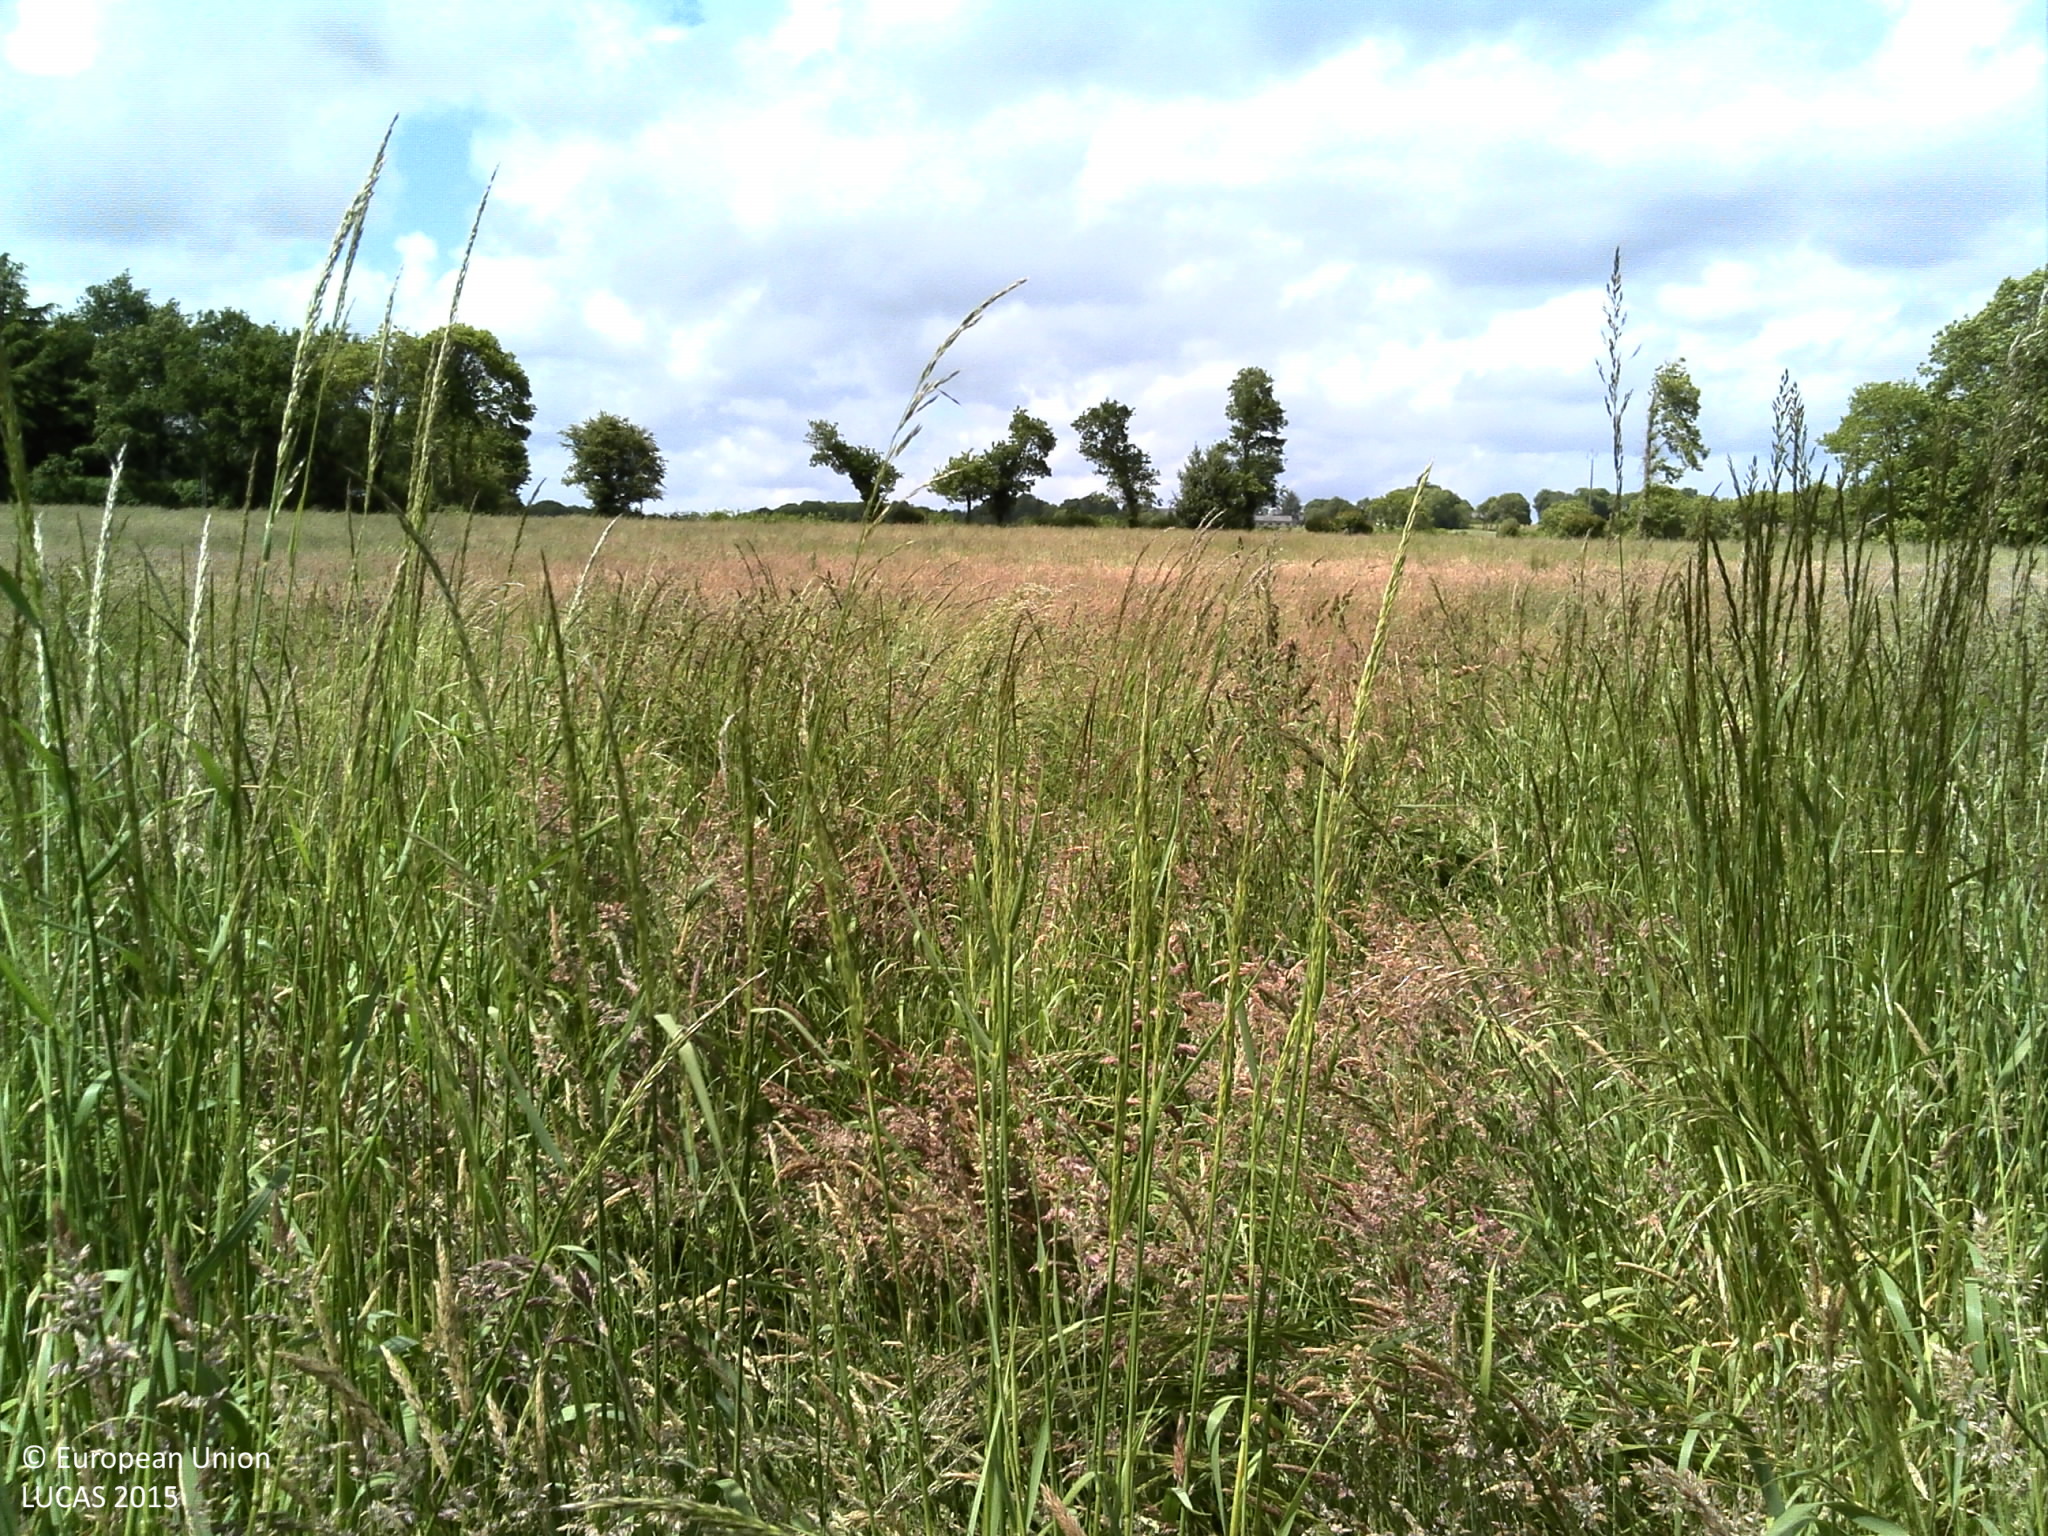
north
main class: Grassland
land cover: Grassland without tree/shrub cover
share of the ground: > 75 %
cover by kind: herbaceous plants 100 %
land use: Agriculture (excluding fallow land and kitchen gardens)
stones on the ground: < 10 %
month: June
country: FR
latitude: 47.9465
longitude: -3.5599
